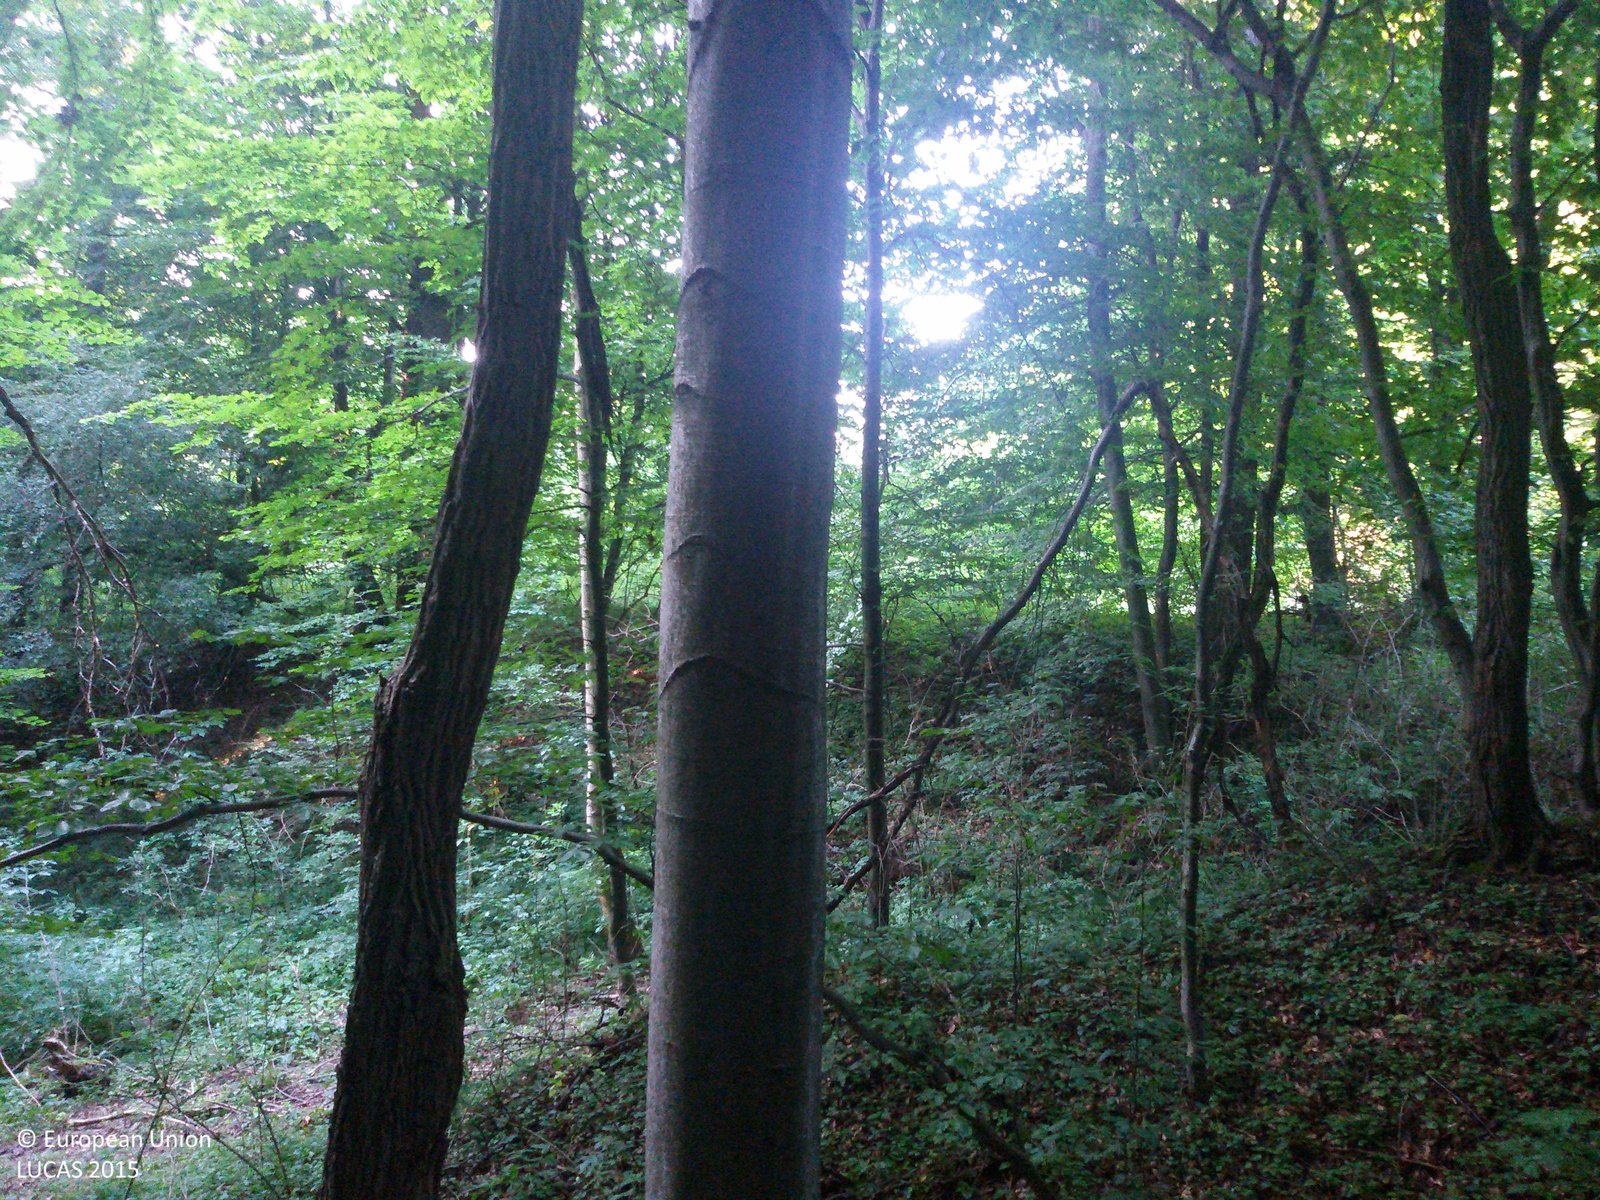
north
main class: Woodland
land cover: Broadleaved woodland
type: mesophytic deciduous forest
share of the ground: > 75 %
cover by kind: broadleaved forest trees 80 %, shrubs 10 %, herbaceous plants 10 %
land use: Forestry
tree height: > 5 m
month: July
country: PL
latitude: 50.9190
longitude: 23.4111
